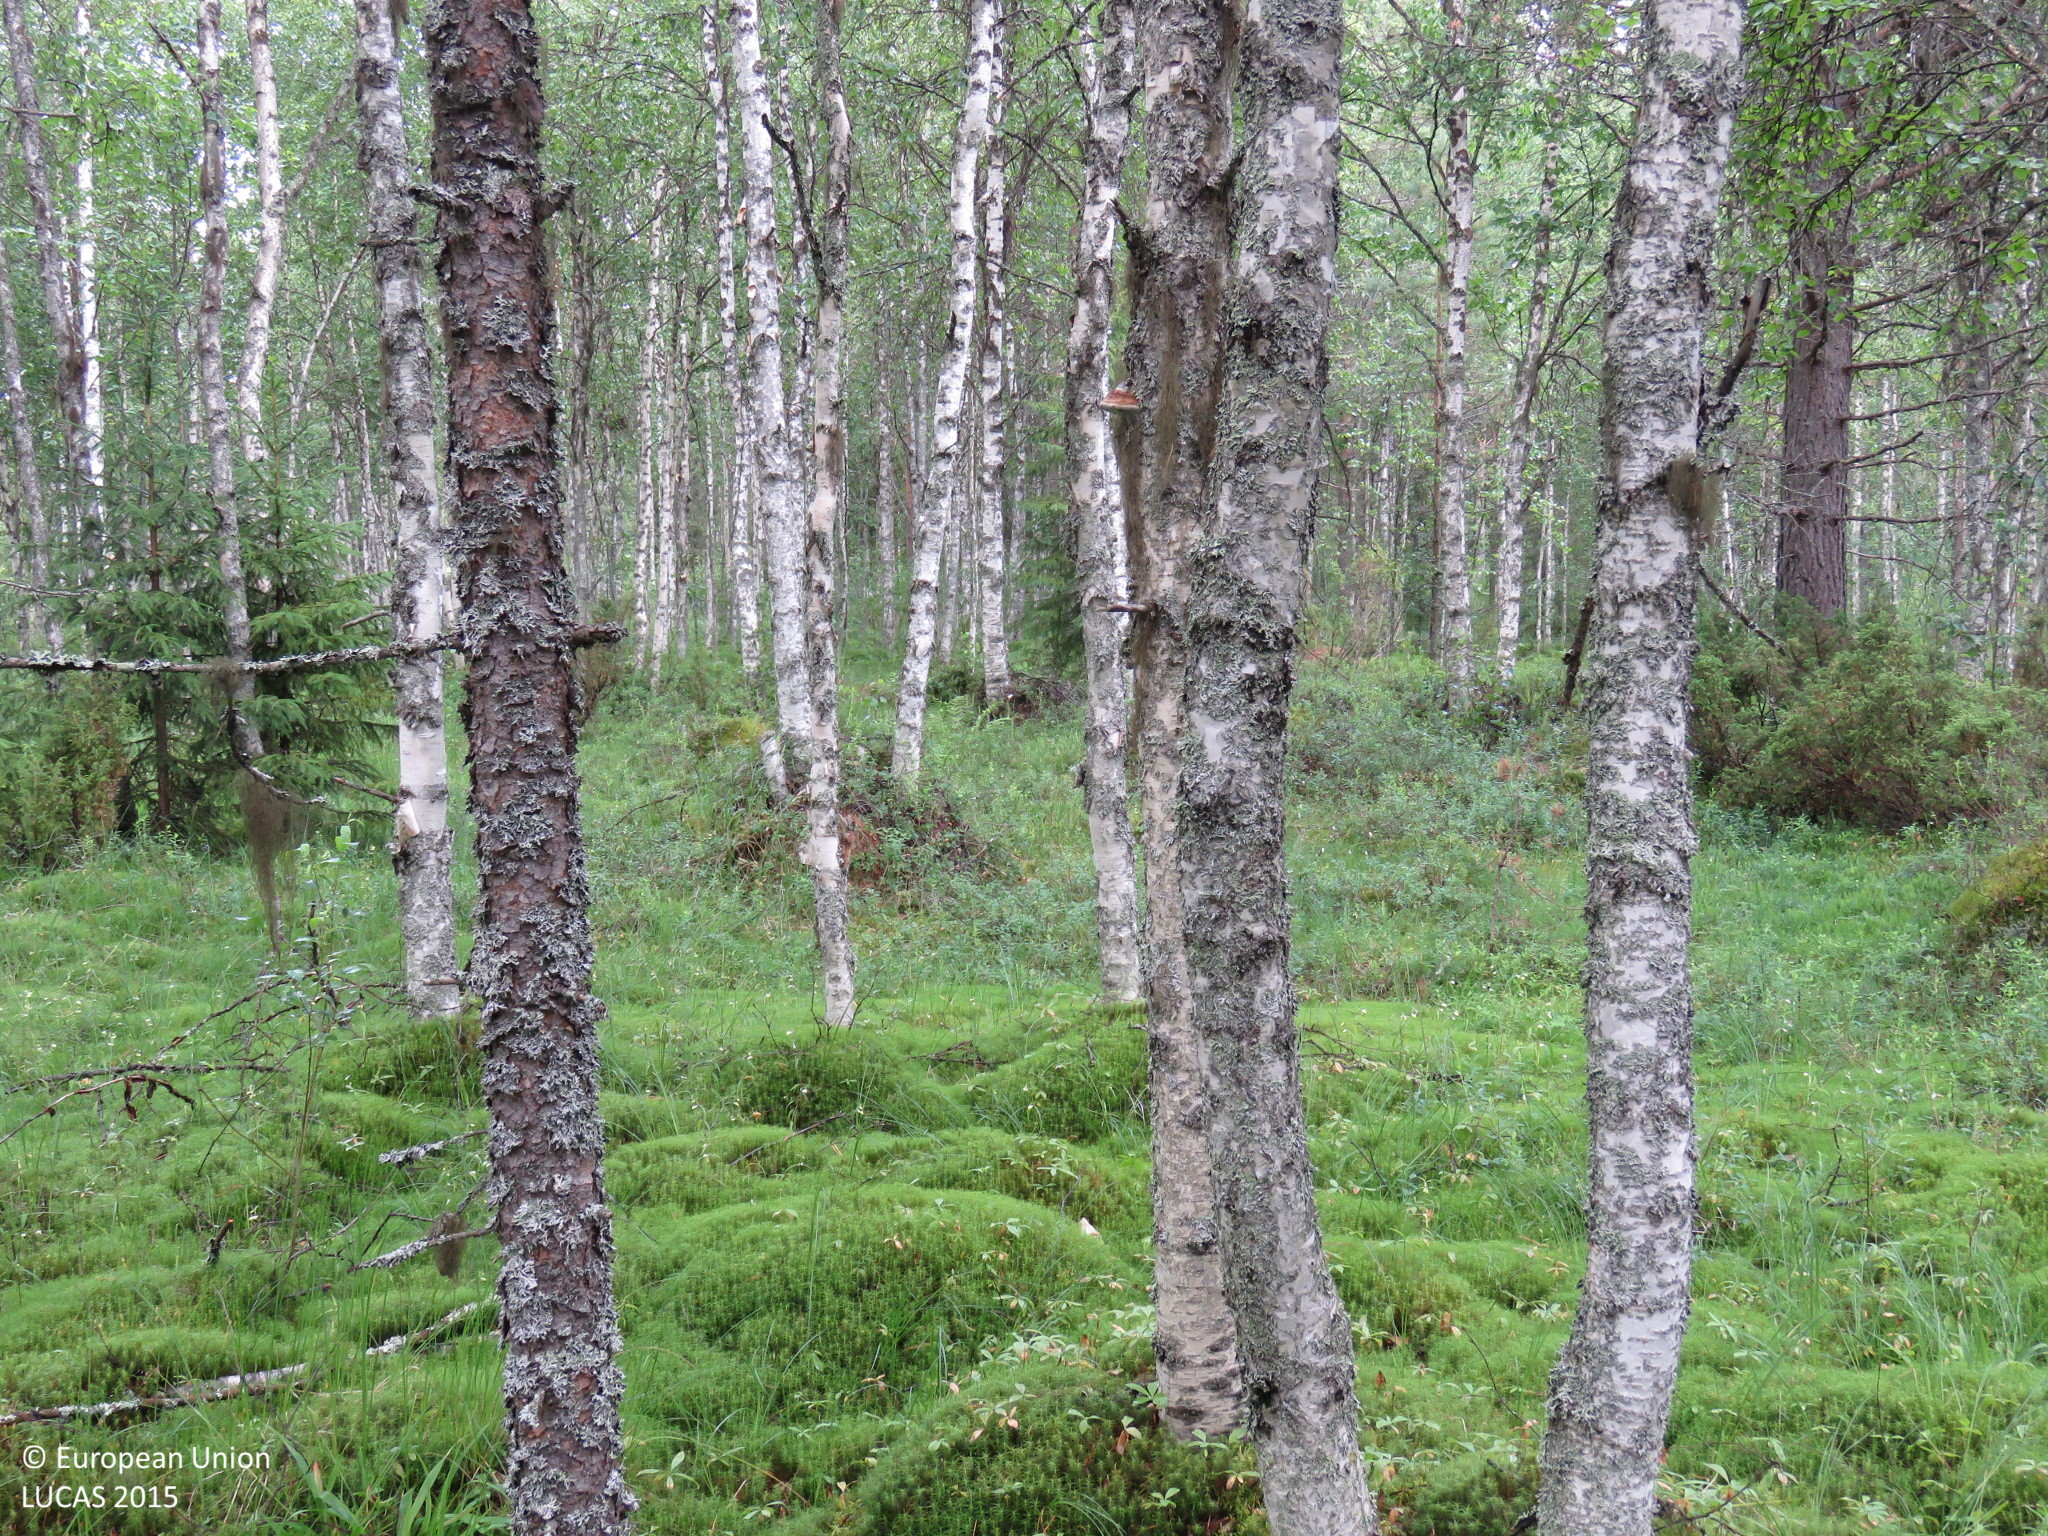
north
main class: Woodland
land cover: Broadleaved woodland
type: non-riverine alder, birch or aspen forest
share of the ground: > 75 %
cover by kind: broadleaved forest trees 65 %, coniferous forest trees 20 %, lichens and mosses 10 %, shrubs 5 %
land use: Forestry
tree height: > 5 m
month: July
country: FI
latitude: 64.4818
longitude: 26.5732
